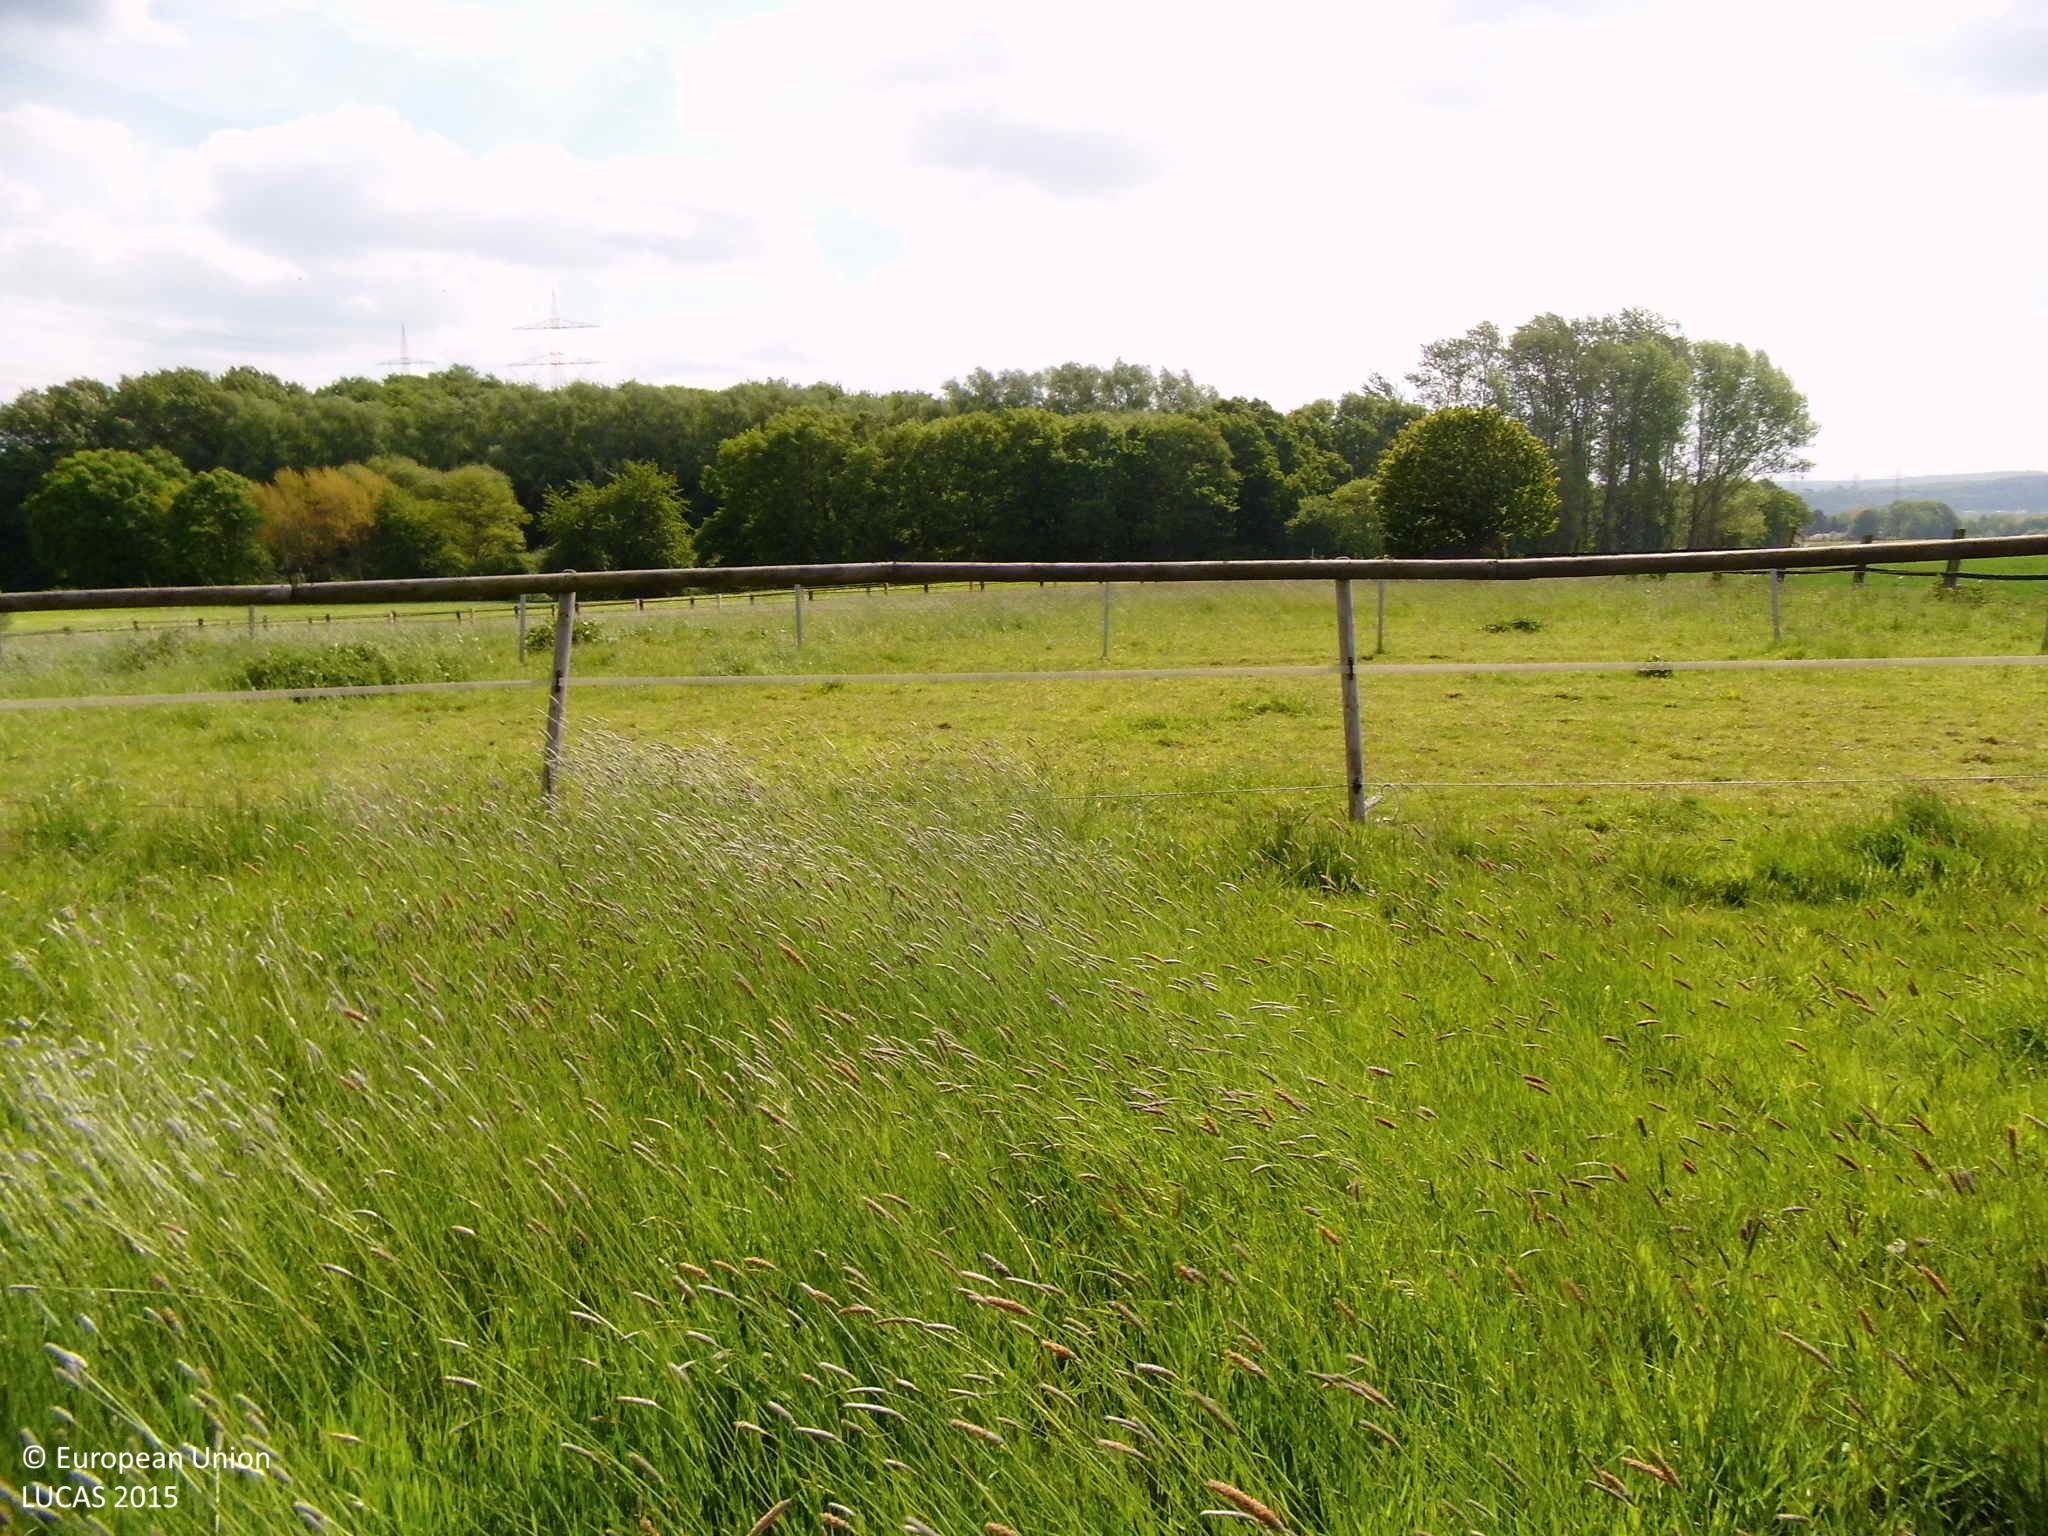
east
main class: Grassland
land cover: Grassland without tree/shrub cover
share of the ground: > 75 %
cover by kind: herbaceous plants 95 %, unconsolidated bare surface 5 %
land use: Agriculture (excluding fallow land and kitchen gardens)
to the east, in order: Grassland without tree/shrub cover; Fences; Grassland without tree/shrub cover; Fences; Grassland without tree/shrub cover; Fences; Grassland without tree/shrub cover; Fences; Grass margins; Paved roads, cycling and walking lanes; Grass margins; Barley; Broadleaved woodland; Rivers and streams; Broadleaved woodland
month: May
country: DE
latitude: 51.4677
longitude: 7.3947
